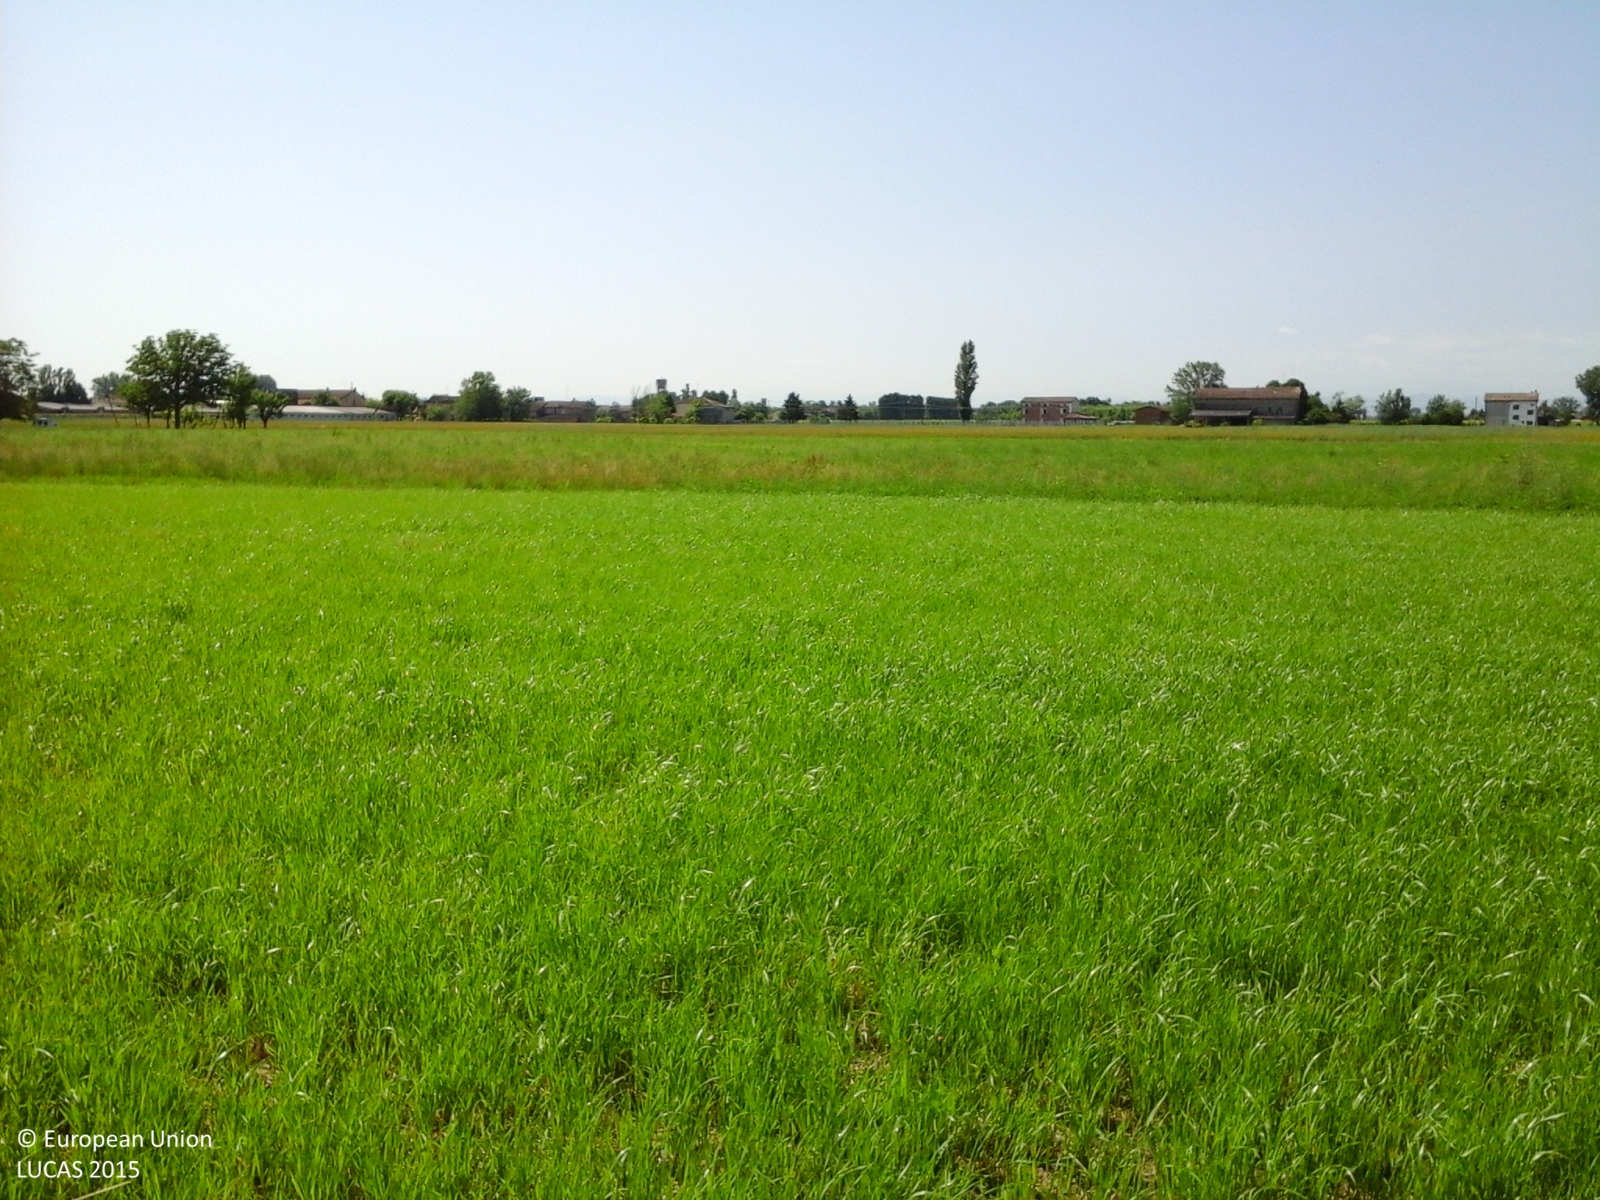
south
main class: Cropland
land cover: Temporary grasslands
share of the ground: > 75 %
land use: Agriculture (excluding fallow land and kitchen gardens)
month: May
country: IT
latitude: 44.8171
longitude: 10.6941
